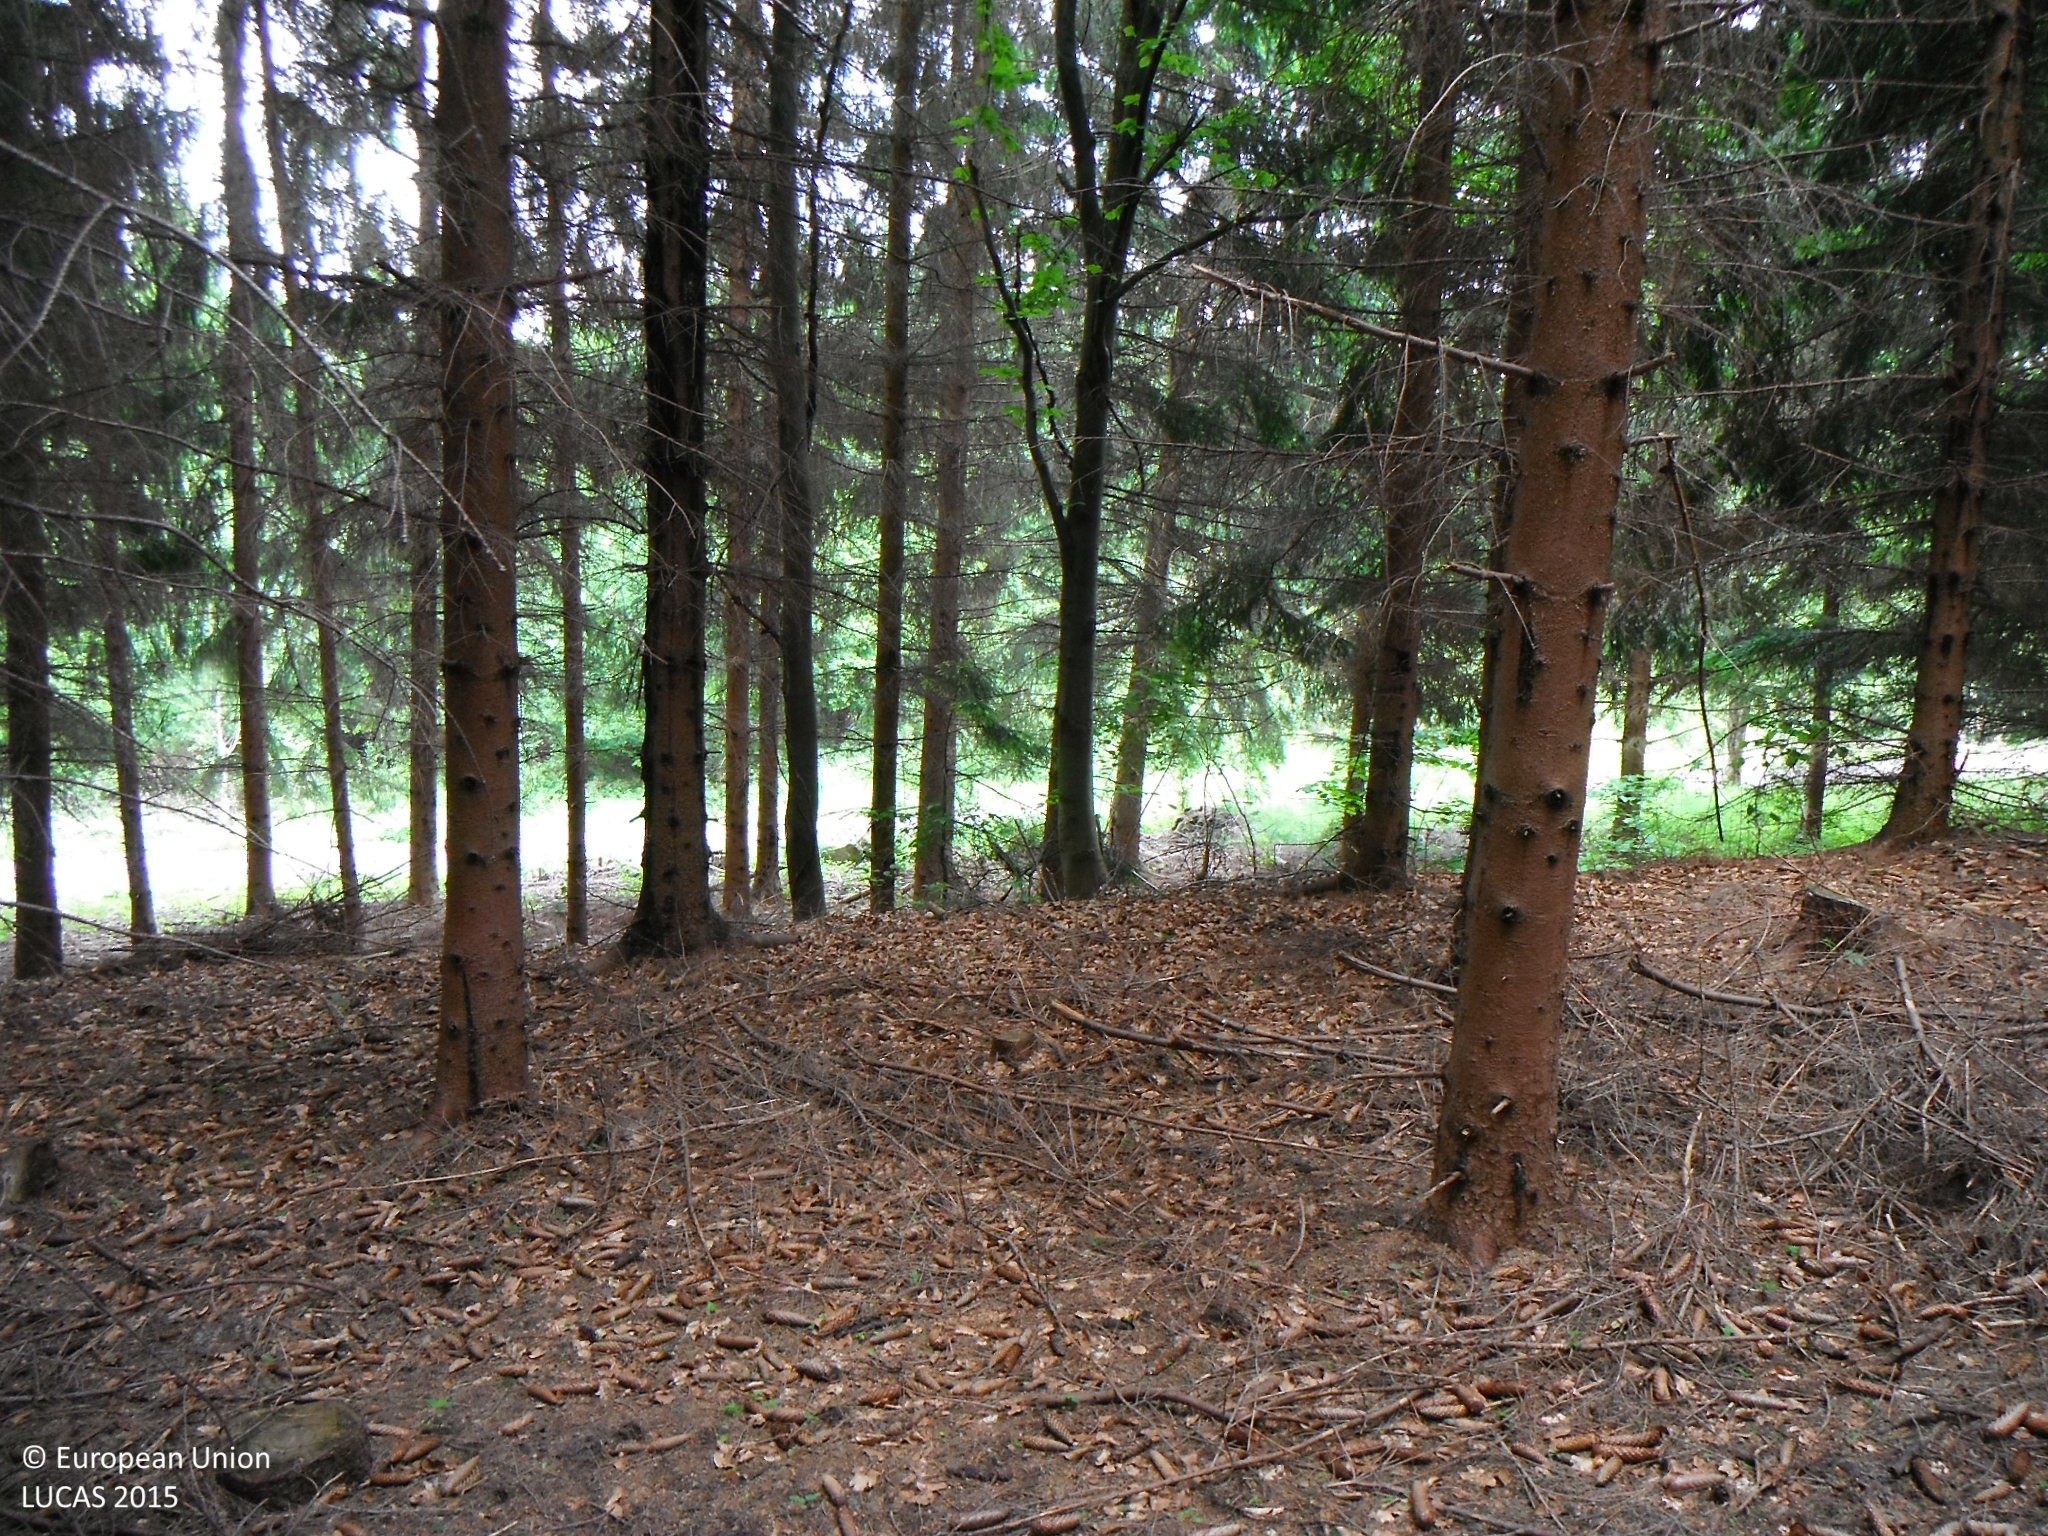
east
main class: Woodland
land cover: Spruce dominated coniferous woodland
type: alpine coniferous forest
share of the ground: > 75 %
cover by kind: coniferous forest trees 100 %
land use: Forestry
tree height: > 5 m
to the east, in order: Spruce dominated coniferous woodland; Grass margins; Paved roads, cycling and walking lanes; Grass margins; Spontaneously vegetated surfaces; Broadleaved woodland; Spruce dominated coniferous woodland; Tracks; Spruce dominated coniferous woodland; Tracks; Spruce dominated coniferous woodland; Tracks; Spruce dominated coniferous woodland; Artificial constructions in urban areas; Spruce dominated coniferous woodland; Pine dominated mixed woodland
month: June
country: SK
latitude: 48.4377
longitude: 19.3911
